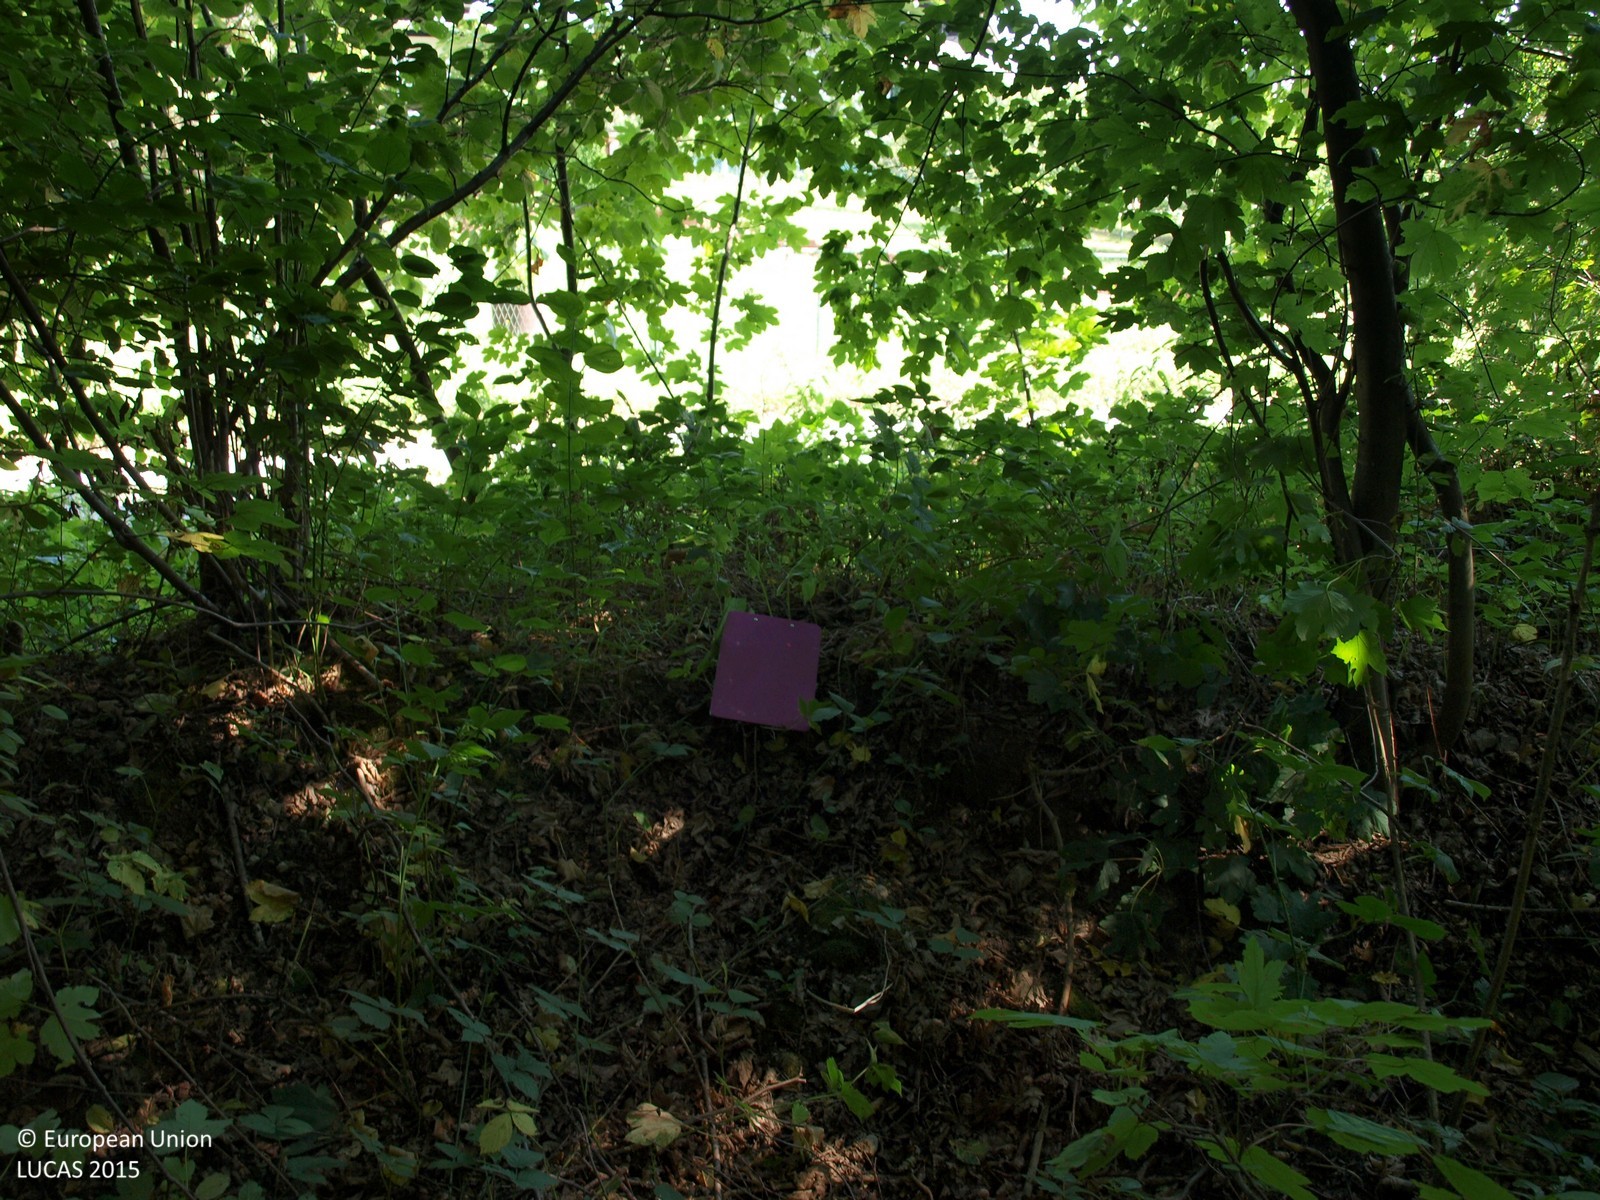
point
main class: Woodland
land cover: Broadleaved woodland
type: mesophytic deciduous forest
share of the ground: > 75 %
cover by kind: broadleaved forest trees 100 %
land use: Forestry
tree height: > 5 m
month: August
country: HR
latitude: 45.8780
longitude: 16.2733
